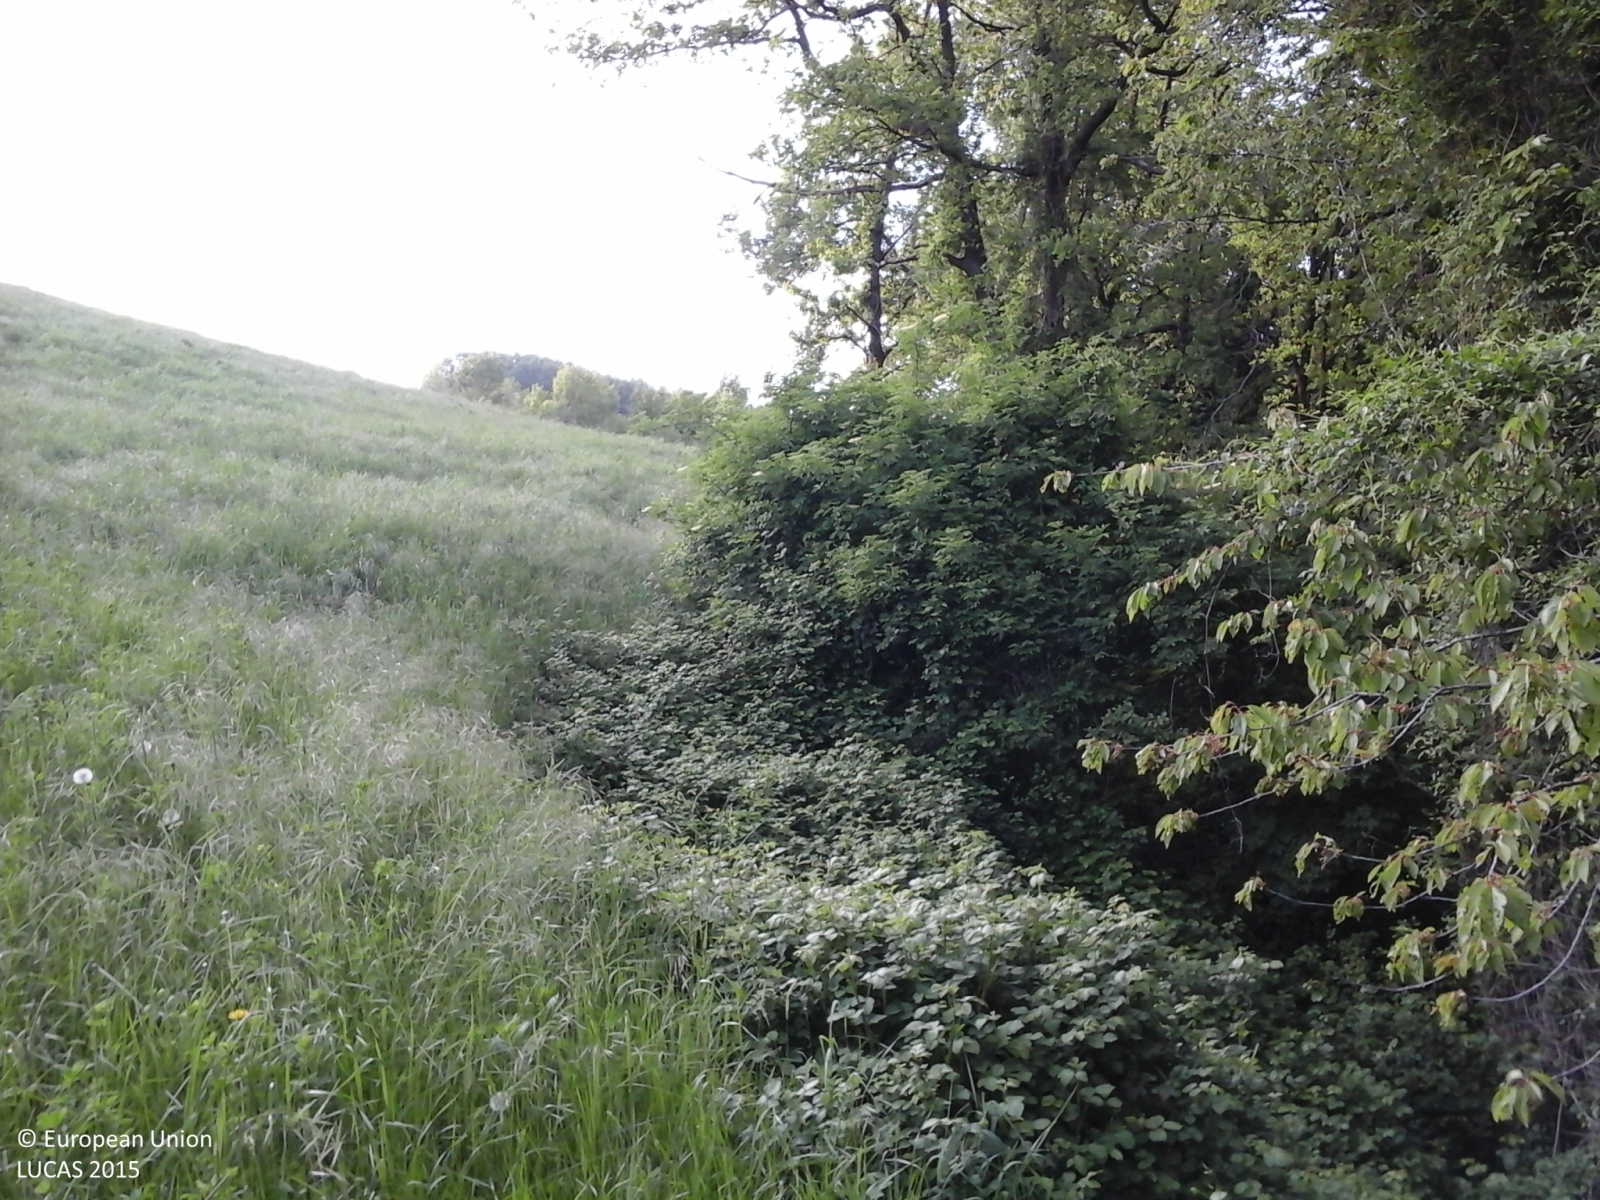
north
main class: Woodland
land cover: Broadleaved woodland
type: mesophytic deciduous forest
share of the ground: > 75 %
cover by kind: broadleaved forest trees 80 %, shrubs 20 %
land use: Forestry
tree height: > 5 m
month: April
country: IT
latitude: 44.9081
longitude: 9.4565
